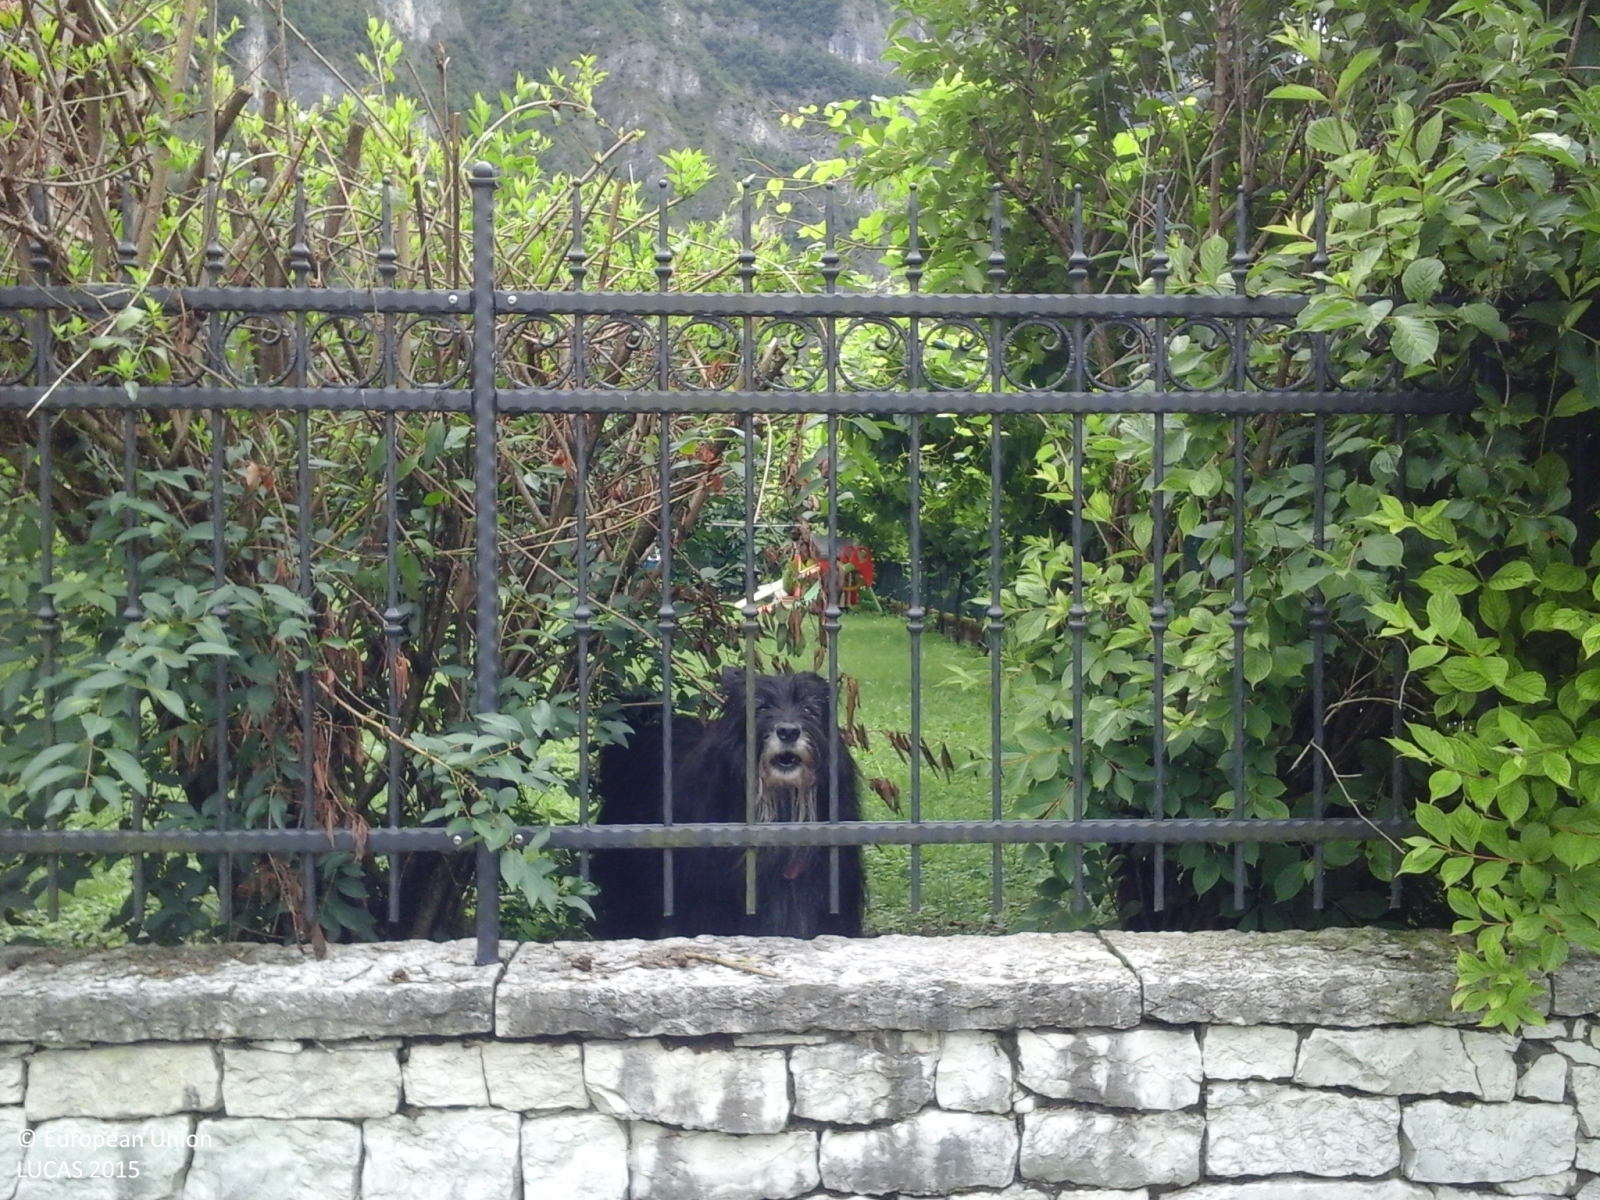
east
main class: Grassland
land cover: Grassland without tree/shrub cover
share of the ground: > 75 %
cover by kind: herbaceous plants 100 %
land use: Residential
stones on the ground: < 10 %
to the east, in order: Grassland without tree/shrub cover; Artificial constructions in urban areas; Grassland without tree/shrub cover; Artificial constructions in urban areas; Lines of trees; Grassland without tree/shrub cover; Fences; Grassland with sparse tree/shrub cover; Lines of trees; Grass margins; Artificial constructions in urban areas
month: June
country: IT
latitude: 46.0144
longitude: 11.6380
